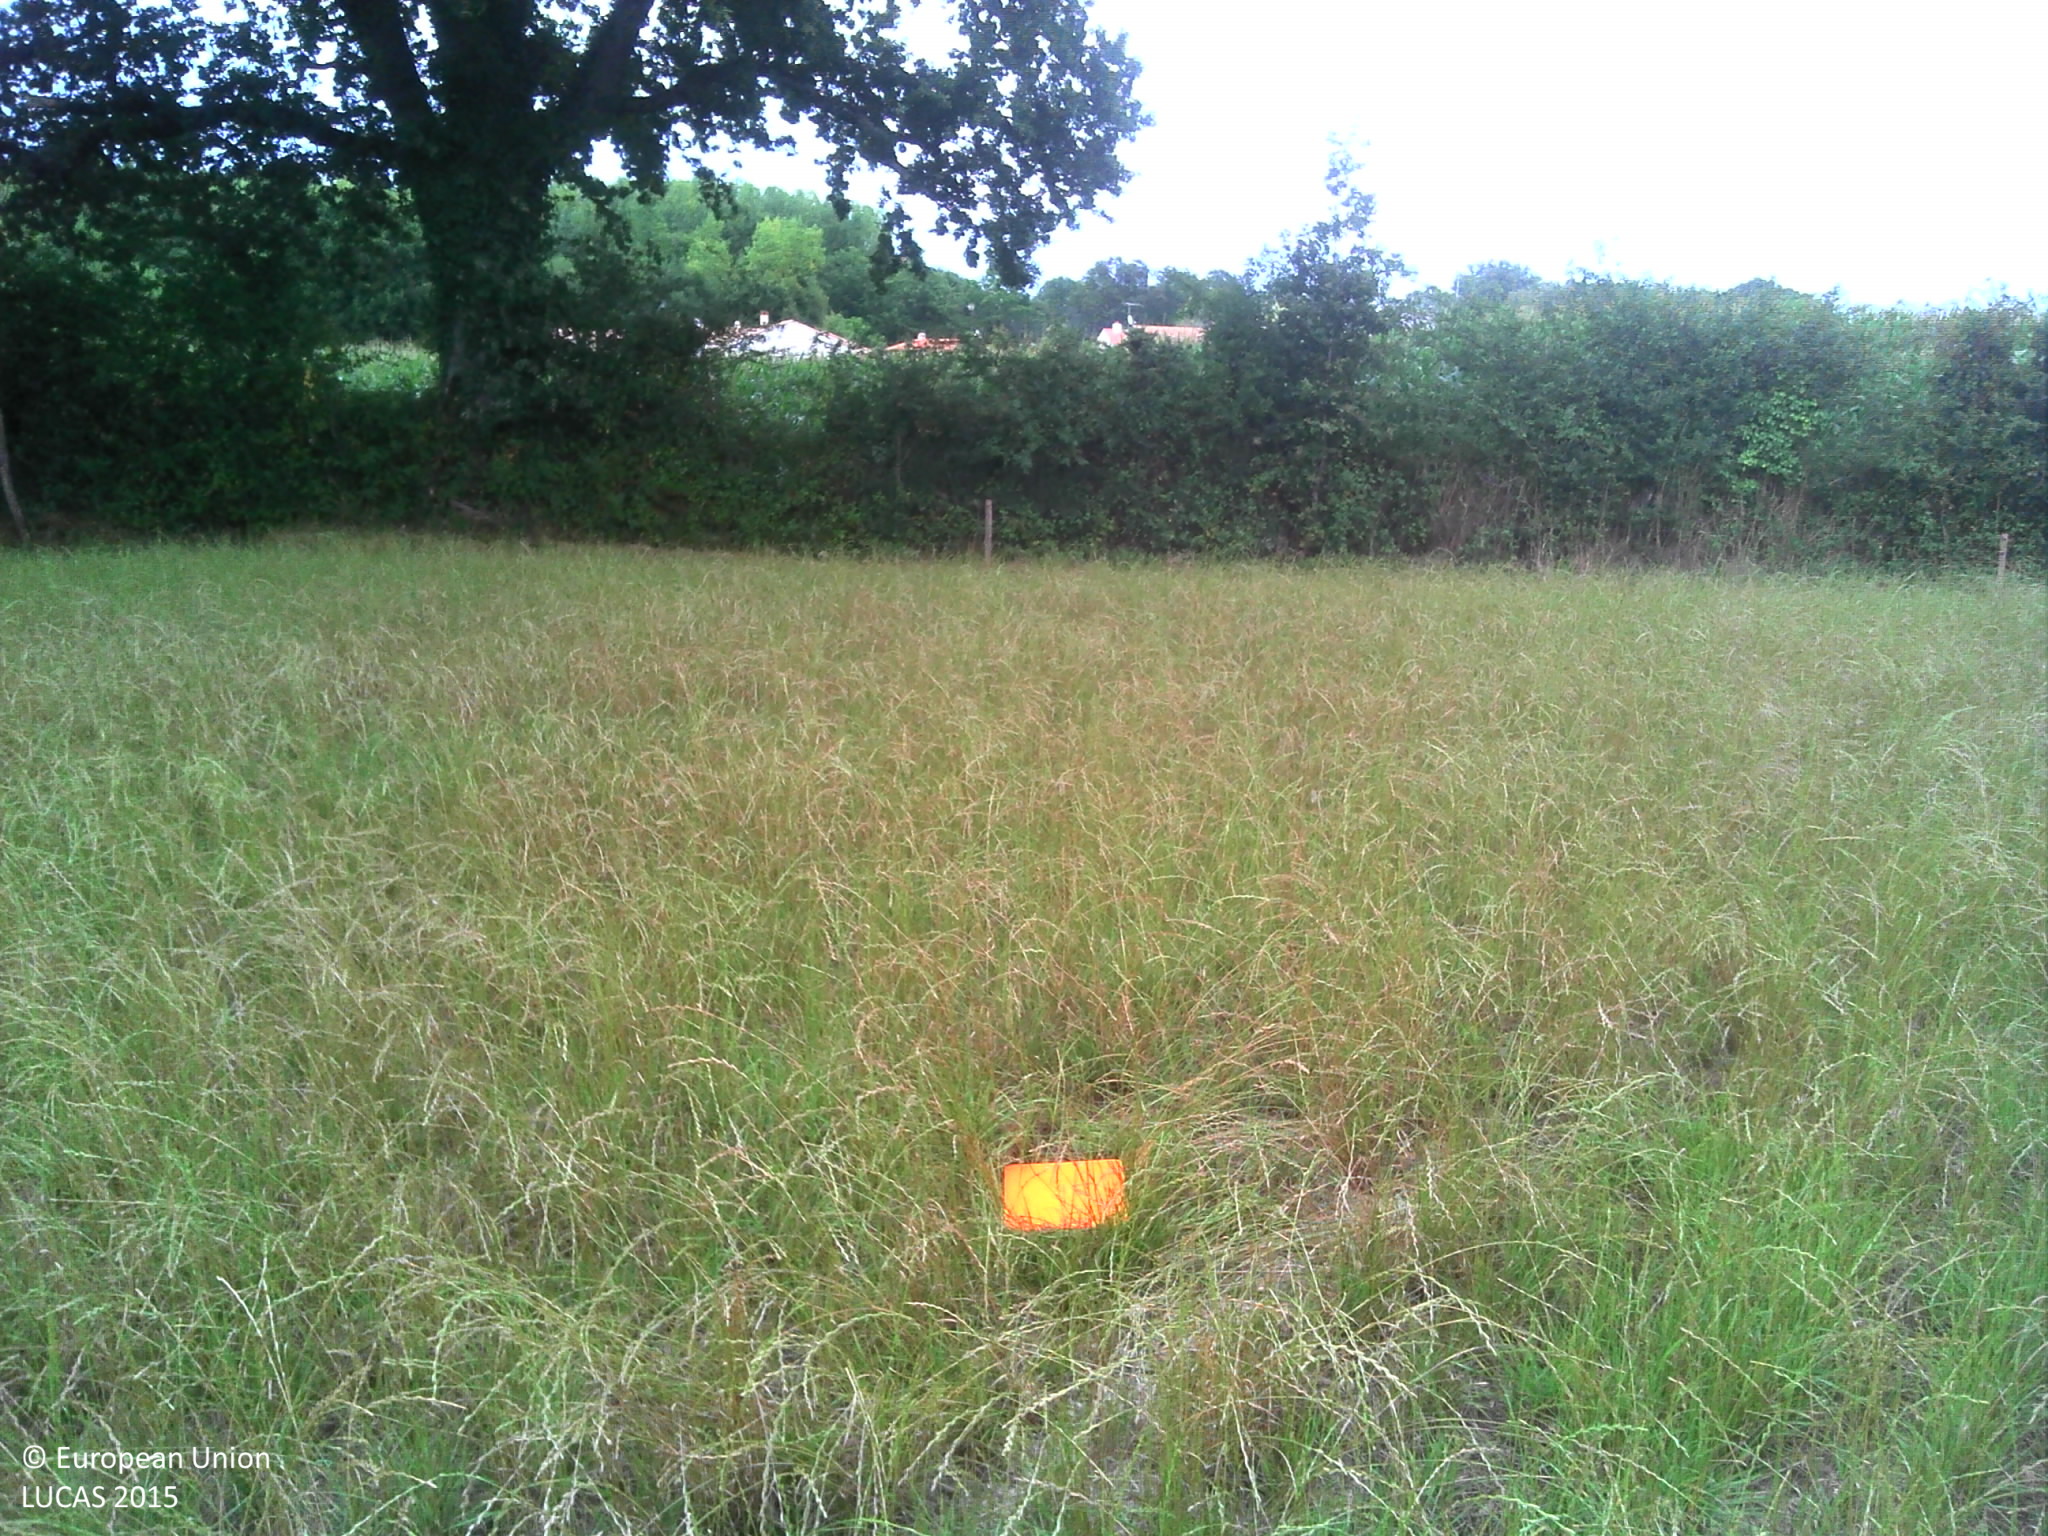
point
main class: Grassland
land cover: Grassland without tree/shrub cover
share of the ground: > 75 %
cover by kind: herbaceous plants 100 %
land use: Agriculture (excluding fallow land and kitchen gardens)
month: August
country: FR
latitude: 46.6422
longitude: -1.6282
